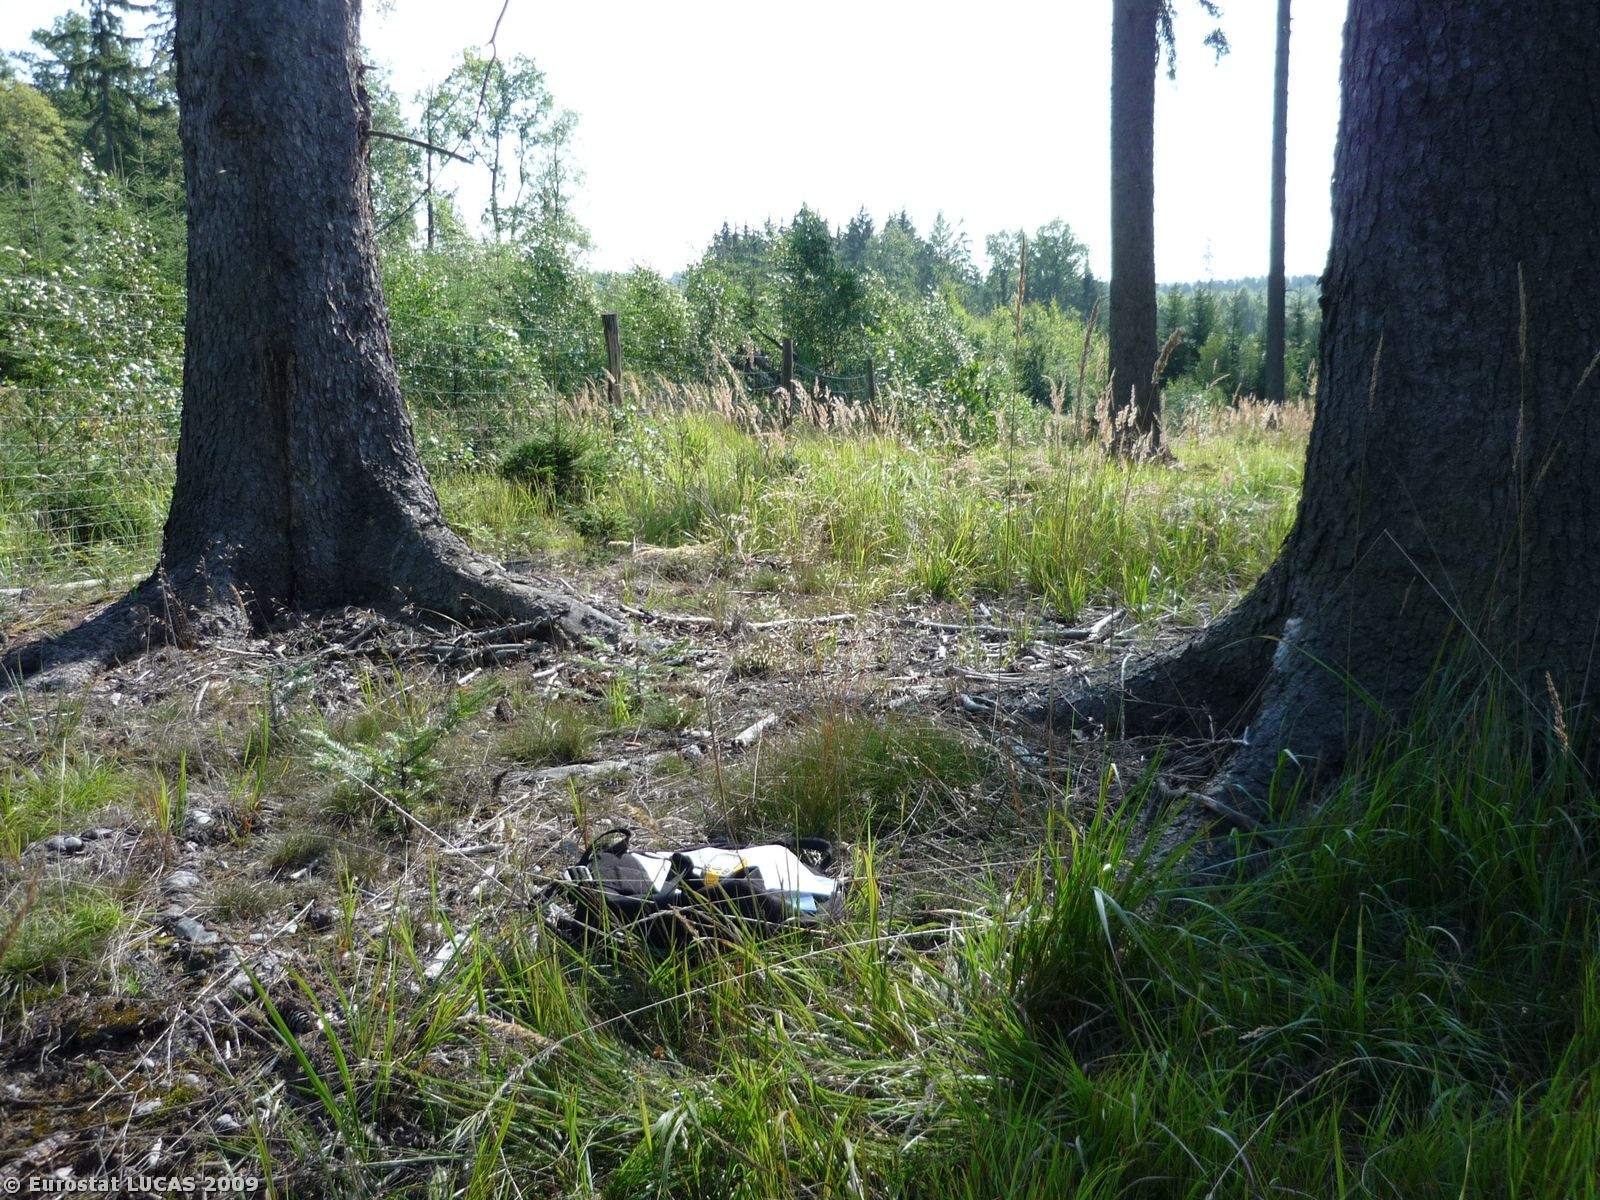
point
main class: Woodland
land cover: Coniferous woodland
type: hemiboreal forest and nemoral coniferous forest and mixed broadleaved-coniferous forest
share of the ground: 50 - 75 %
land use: Forestry
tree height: > 5 m
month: August
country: PL
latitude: 51.0146
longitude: 16.0641
